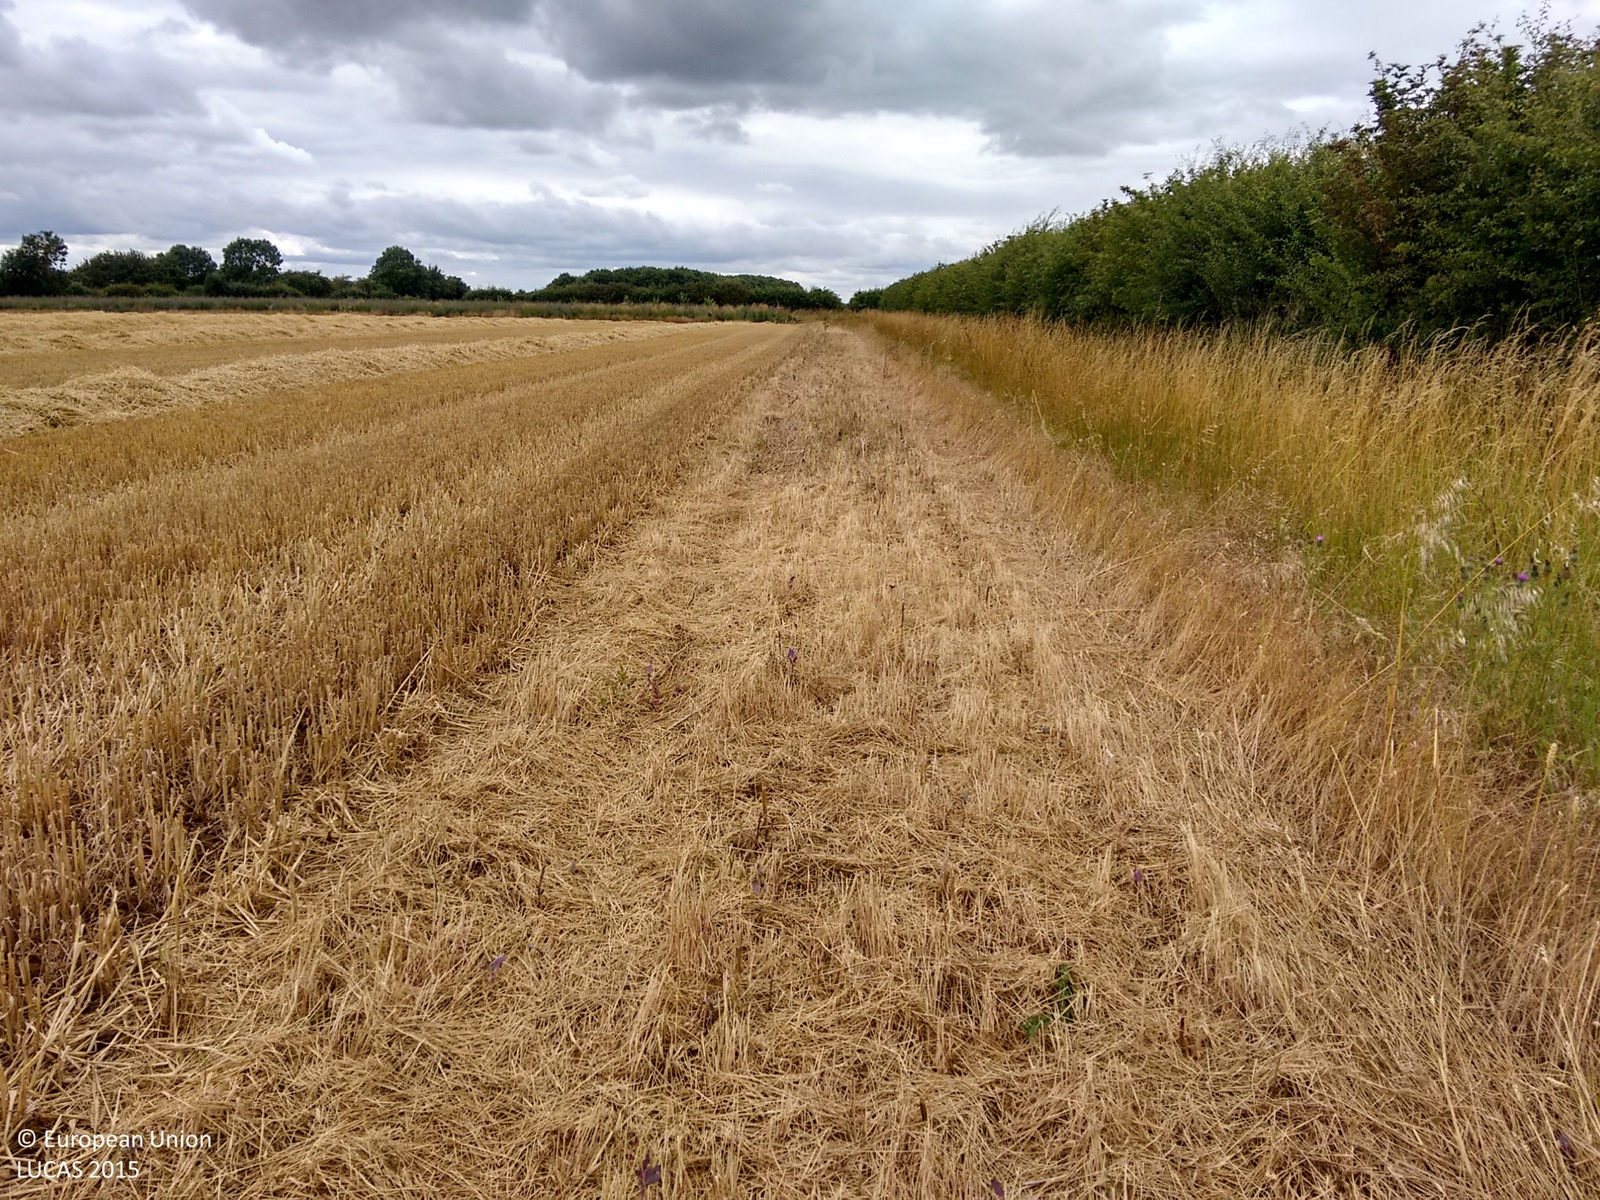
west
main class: Grassland
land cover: Grassland without tree/shrub cover
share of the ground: > 75 %
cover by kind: herbaceous plants 100 %
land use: Agriculture (excluding fallow land and kitchen gardens)
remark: Harvested field
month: July
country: GB
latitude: 52.8496
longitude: -0.7469
